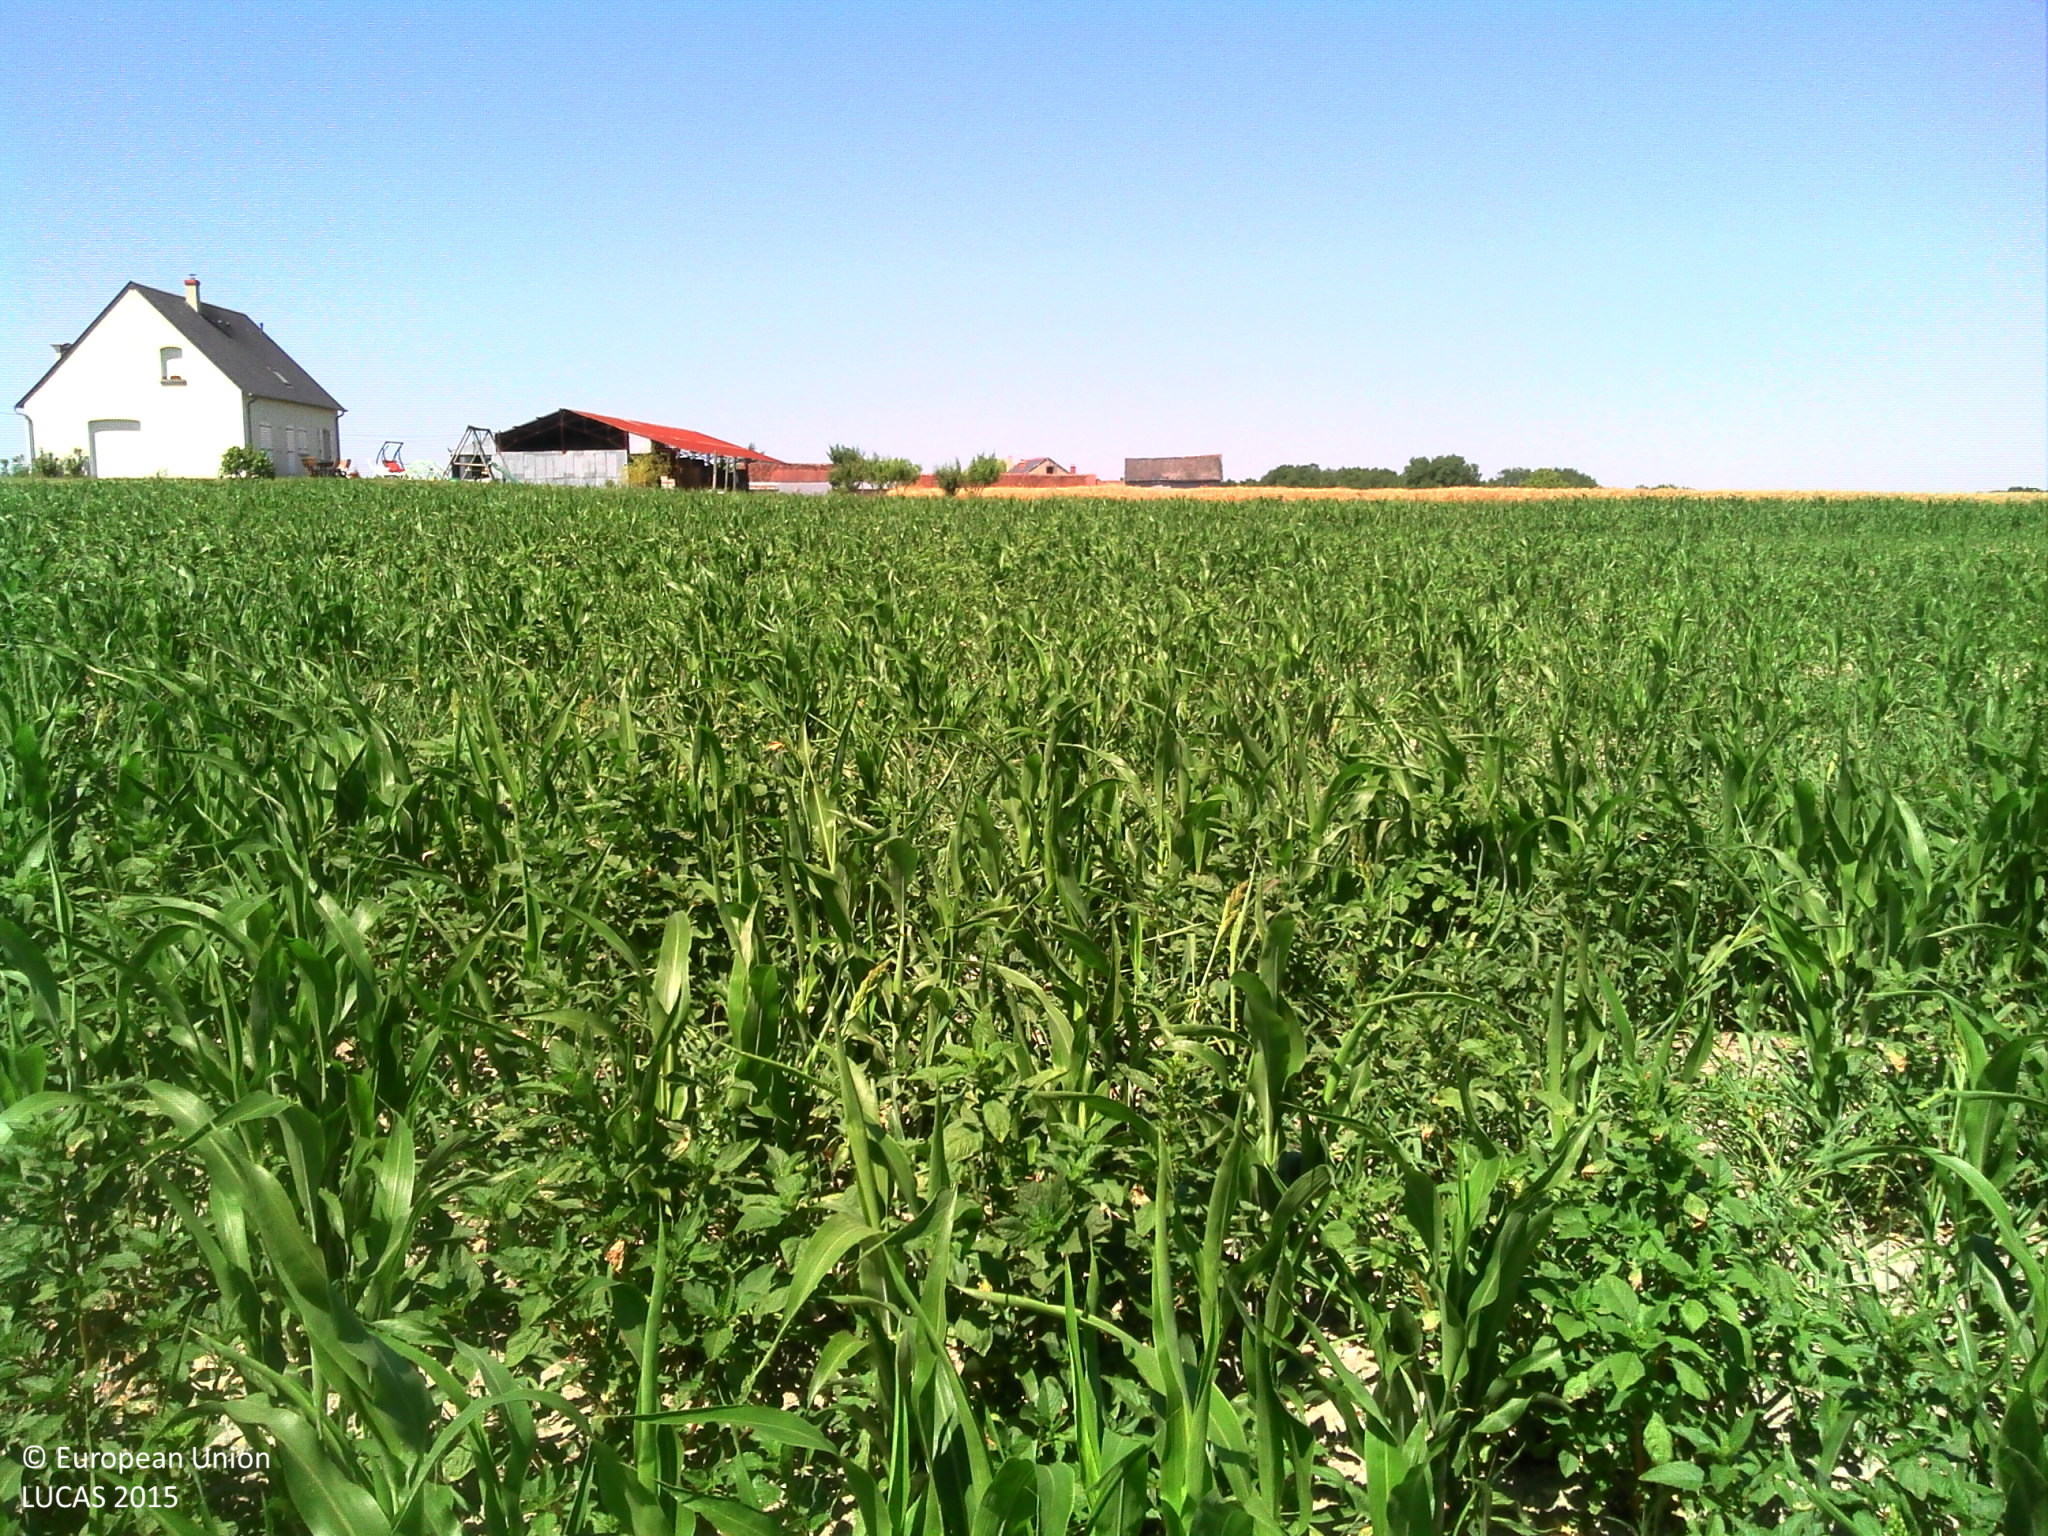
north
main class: Cropland
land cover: Maize
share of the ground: 25 - 50 %
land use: Agriculture (excluding fallow land and kitchen gardens)
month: July
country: FR
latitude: 47.2357
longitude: 0.5353
